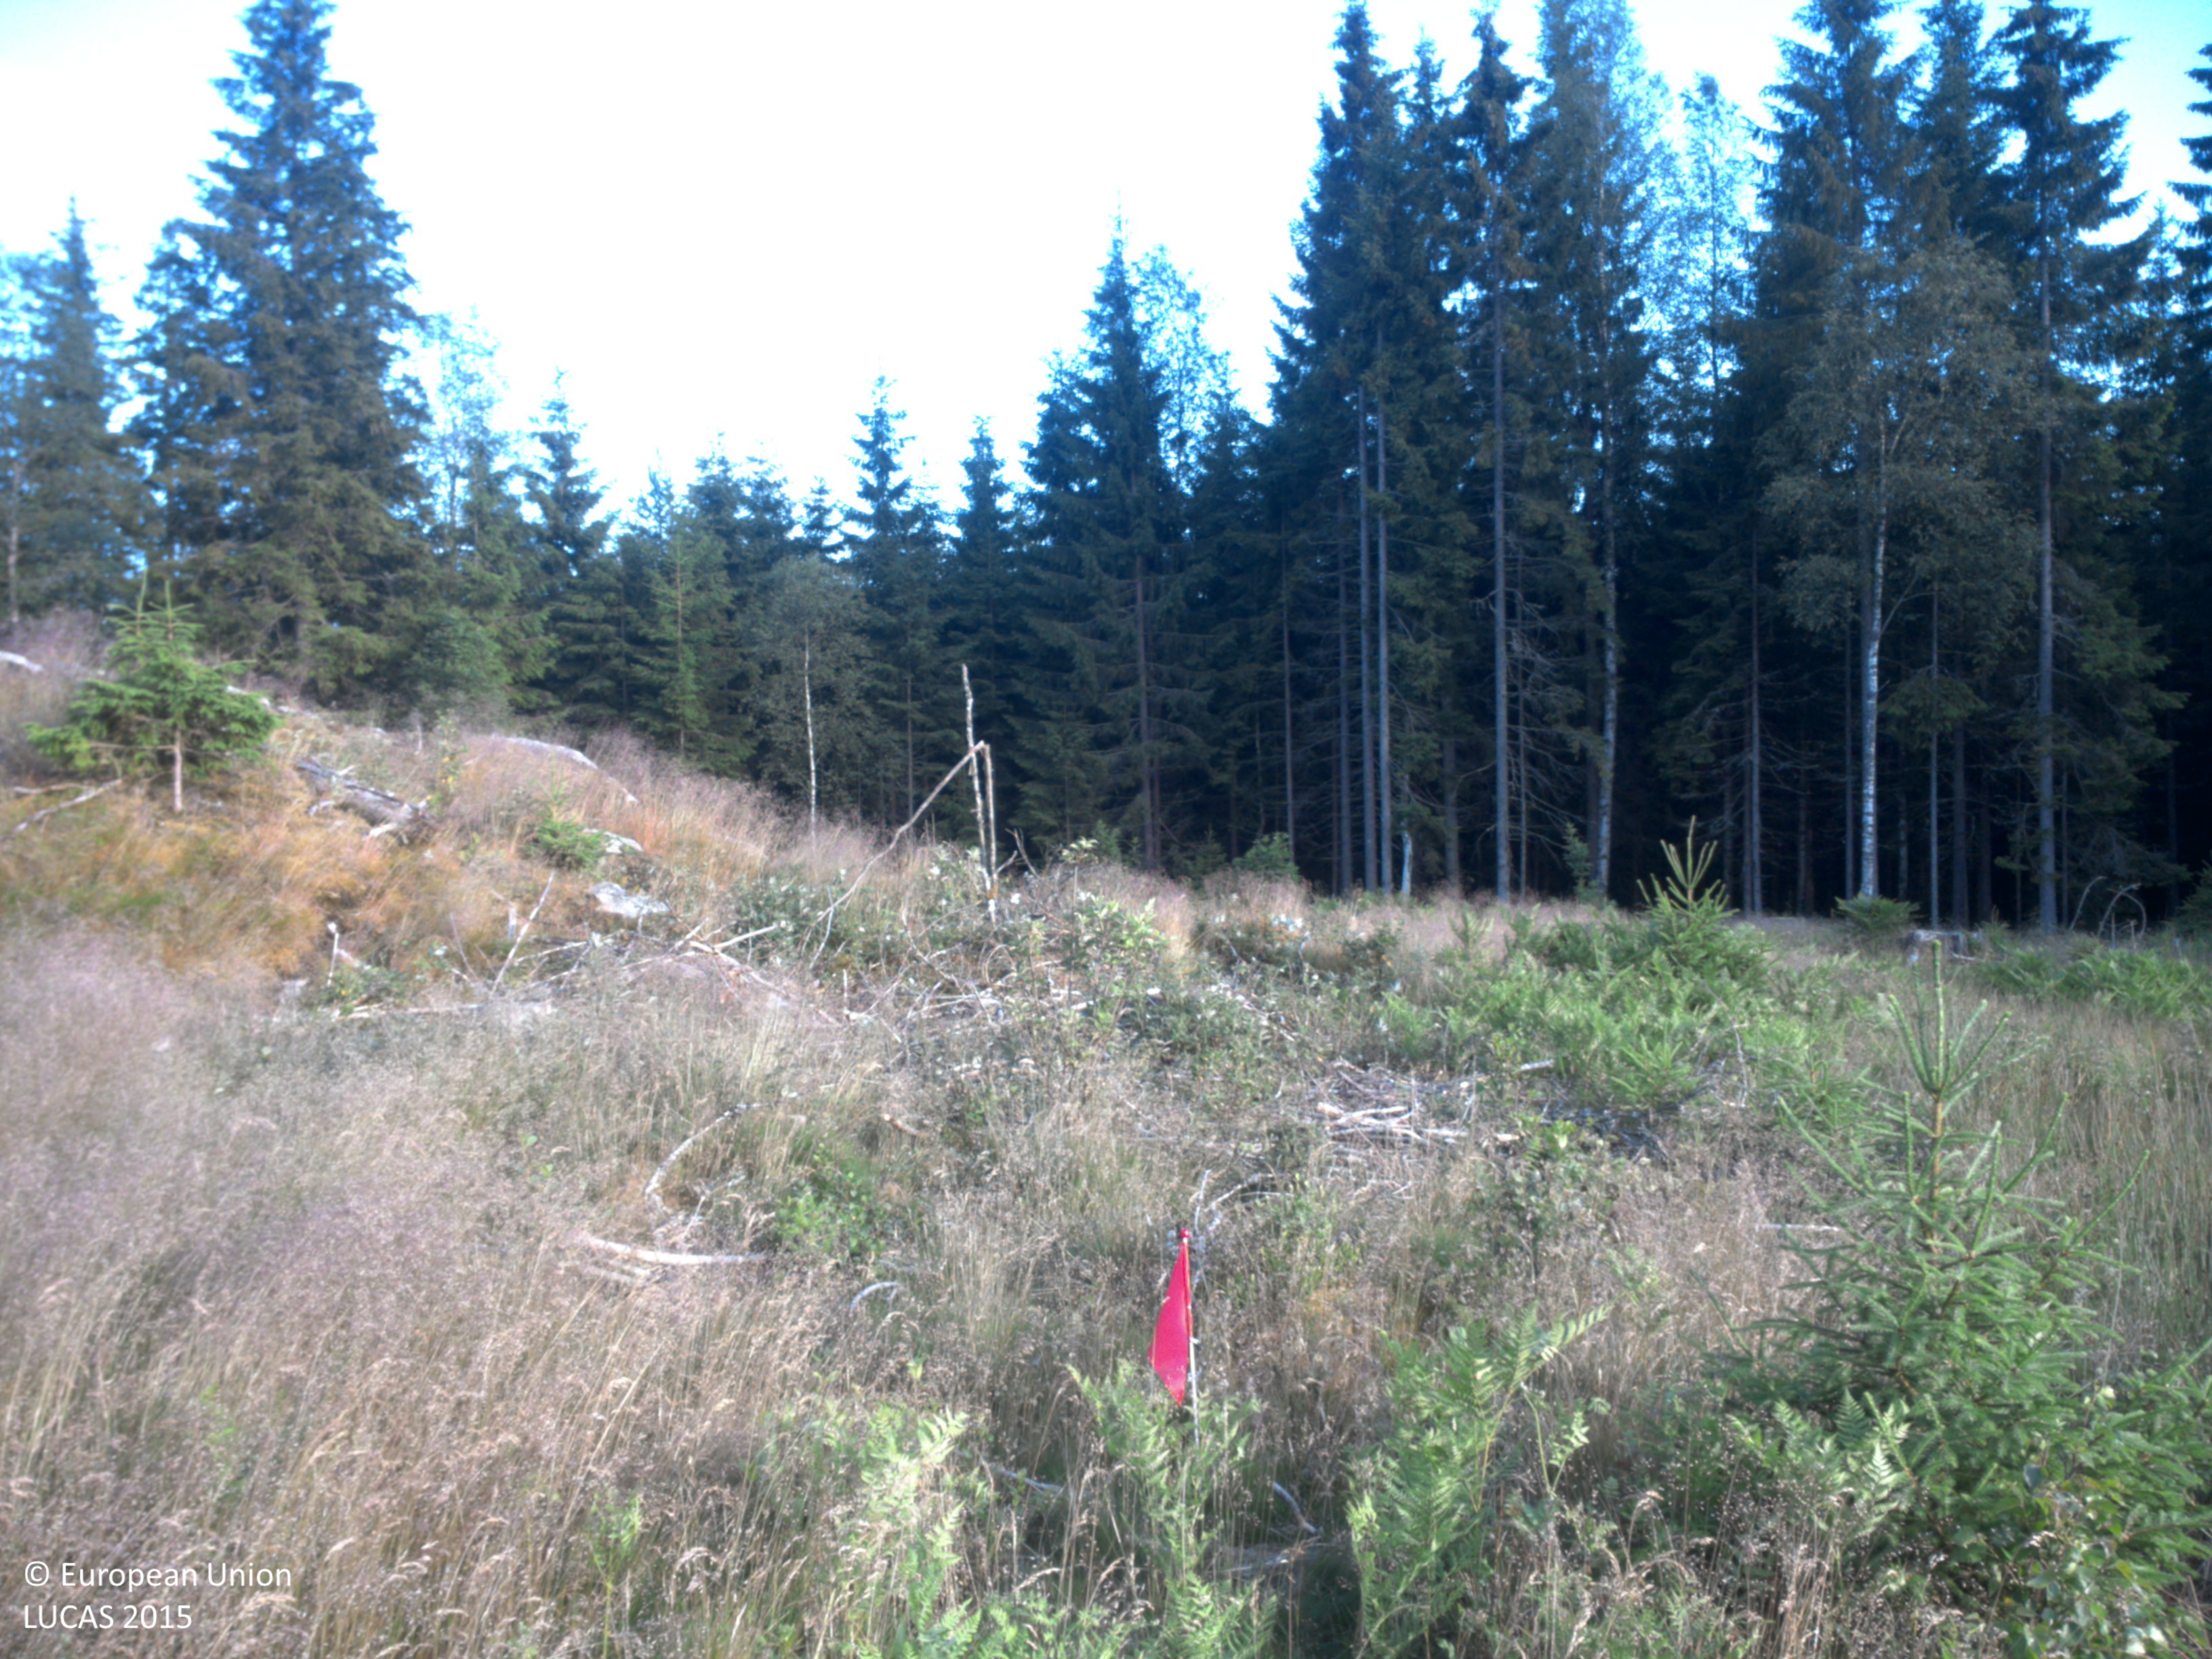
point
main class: Grassland
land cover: Grassland with sparse tree/shrub cover
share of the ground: 25 - 50 %
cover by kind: herbaceous plants 95 %, coniferous forest trees 5 %
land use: Forestry
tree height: < 5 m
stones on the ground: < 10 %
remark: Clear cut
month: July
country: SE
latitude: 58.8360
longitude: 11.8841
